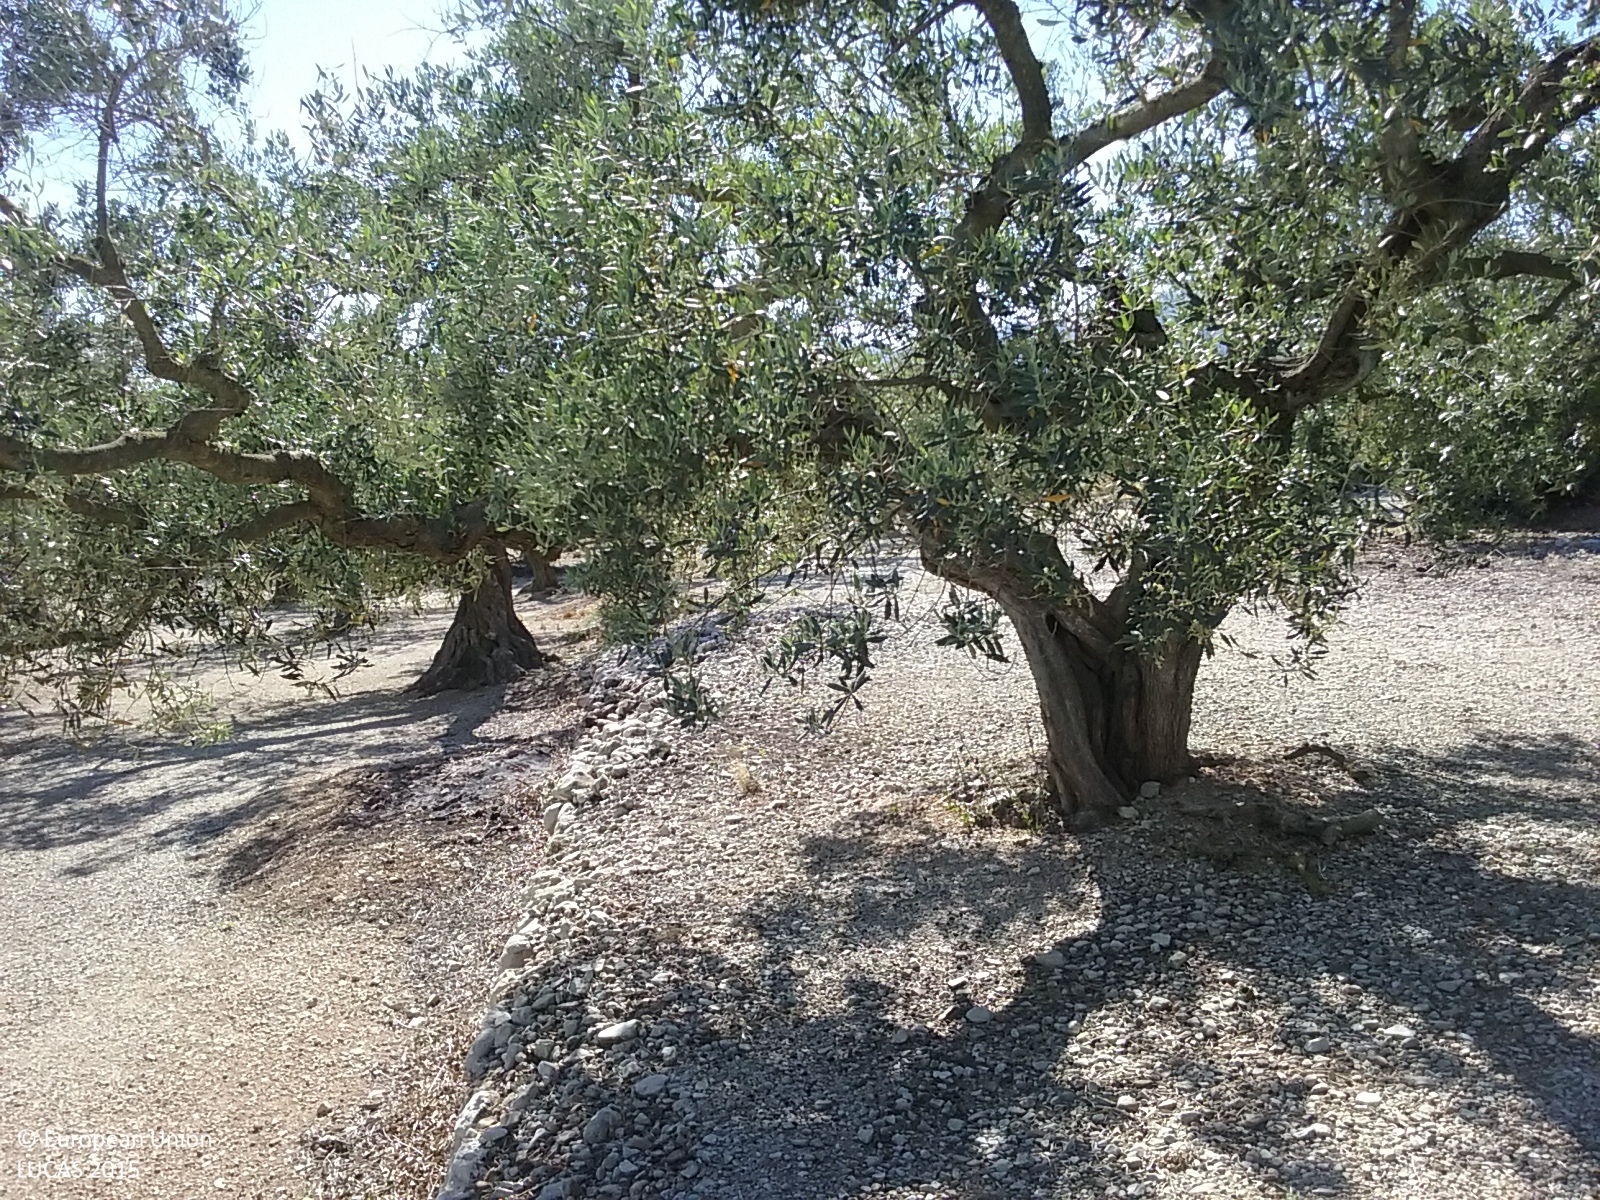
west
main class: Cropland
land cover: Olive groves
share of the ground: 50 - 75 %
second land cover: Other bare soil
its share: > 75 %
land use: Agriculture (excluding fallow land and kitchen gardens)
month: May
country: ES
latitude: 40.7816
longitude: 0.4312
